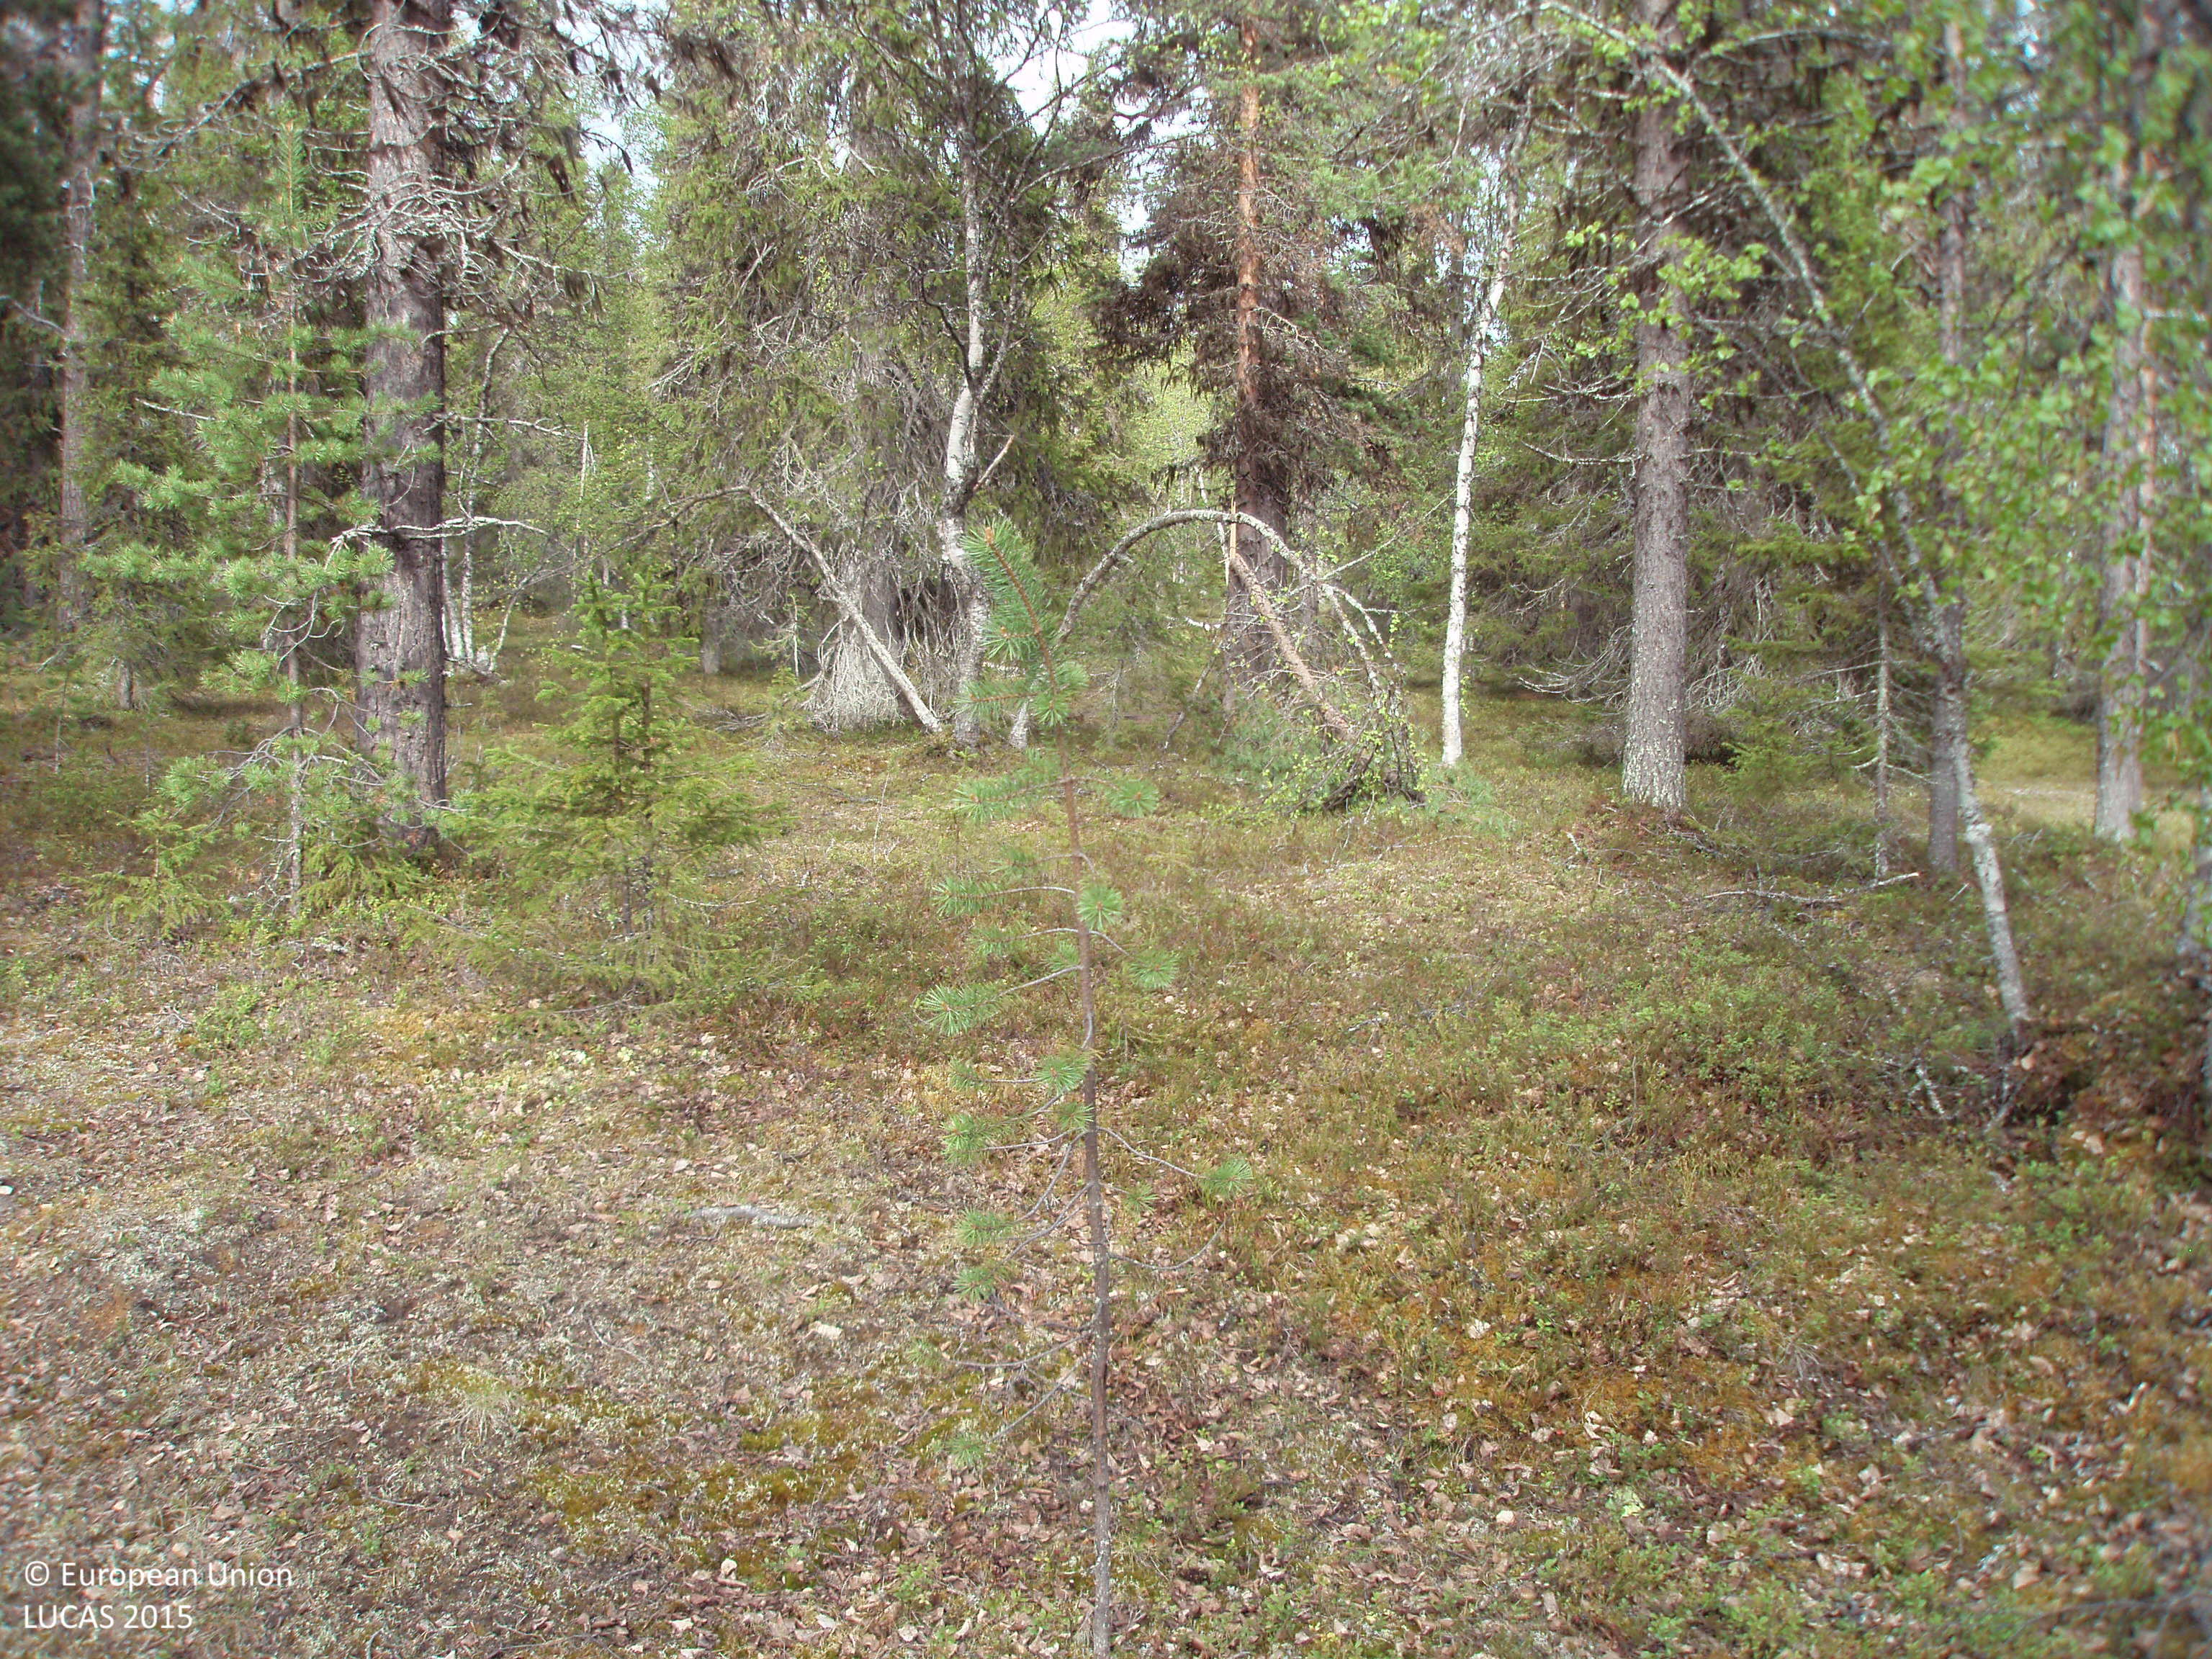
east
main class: Woodland
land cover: Other mixed woodland
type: boreal forest
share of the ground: 50 - 75 %
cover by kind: coniferous forest trees 50 %, broadleaved forest trees 20 %, shrubs 20 %, lichens and mosses 10 %
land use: Forestry
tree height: > 5 m
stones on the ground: 10 - 25 %
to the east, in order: Other mixed woodland; Spruce dominated mixed woodland; Spruce dominated coniferous woodland
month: June
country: FI
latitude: 68.2769
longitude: 26.9936
